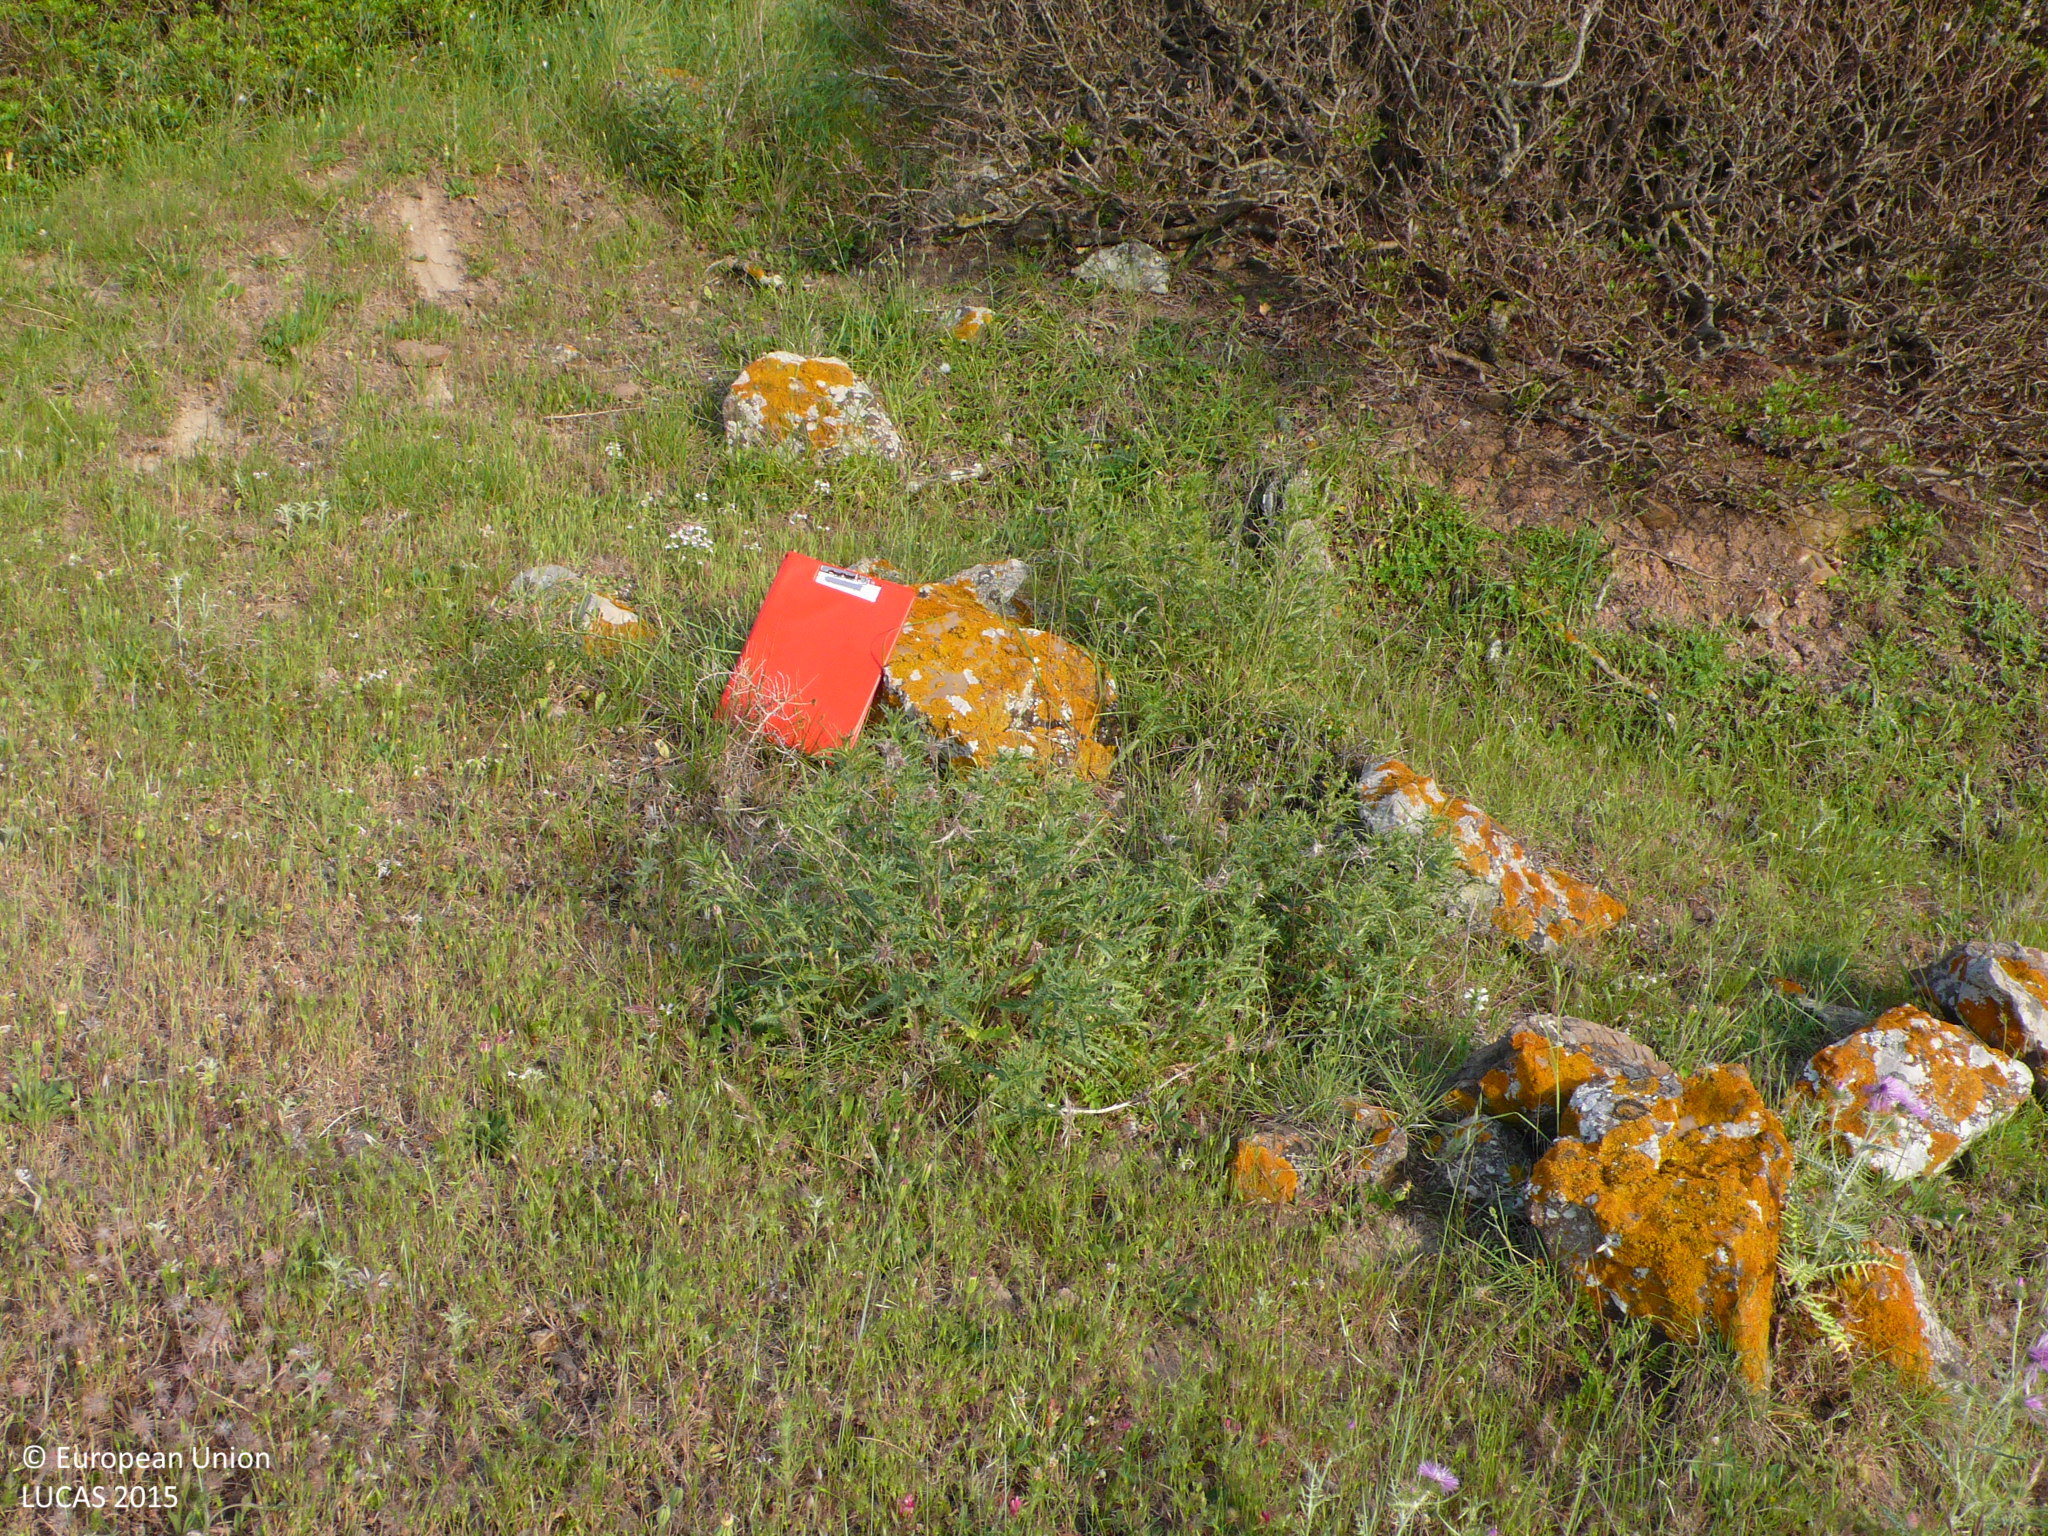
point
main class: Grassland
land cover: Grassland with sparse tree/shrub cover
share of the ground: > 75 %
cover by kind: herbaceous plants 85 %, broadleaved forest trees 5 %, shrubs 5 %, consolidated bare surface 5 %
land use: Agriculture (excluding fallow land and kitchen gardens)
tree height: < 5 m
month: May
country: ES
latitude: 40.0343
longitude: 4.0841
